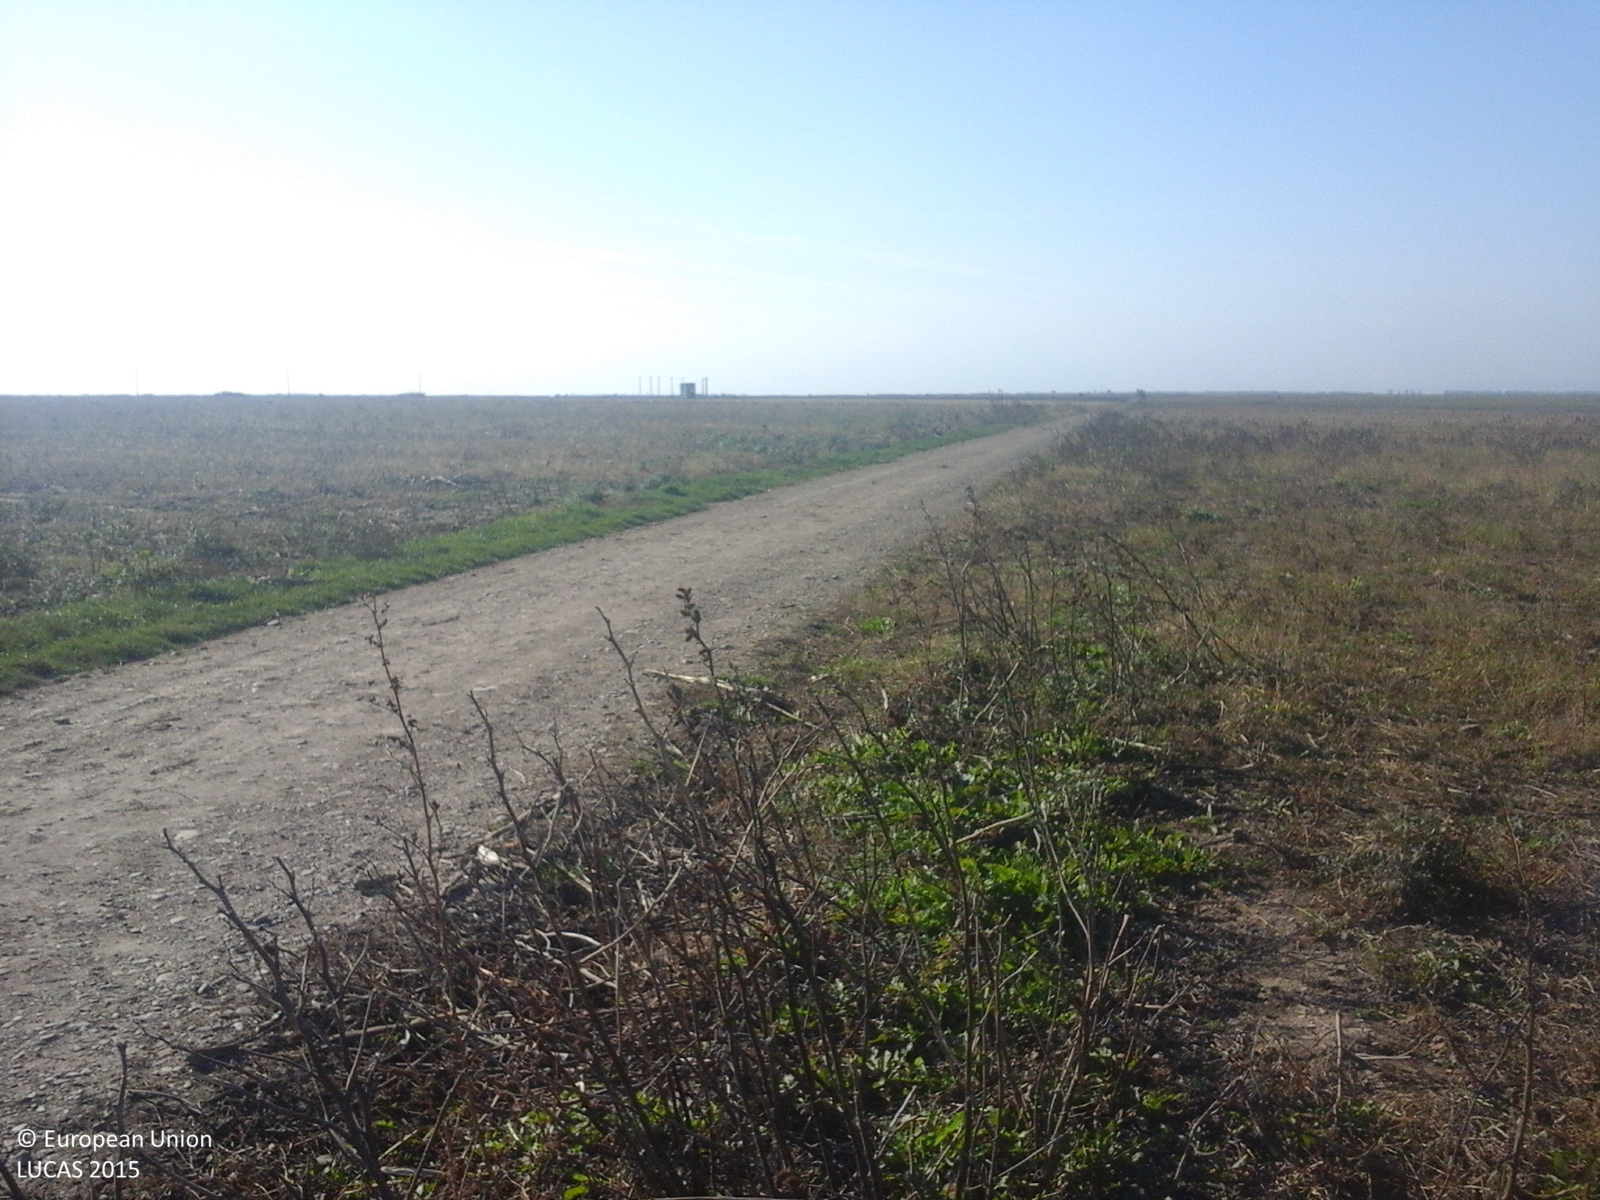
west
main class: Grassland
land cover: Spontaneously vegetated surfaces
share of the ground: > 75 %
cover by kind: herbaceous plants 100 %
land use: Fallow land
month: October
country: RO
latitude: 45.2489
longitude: 27.3602
